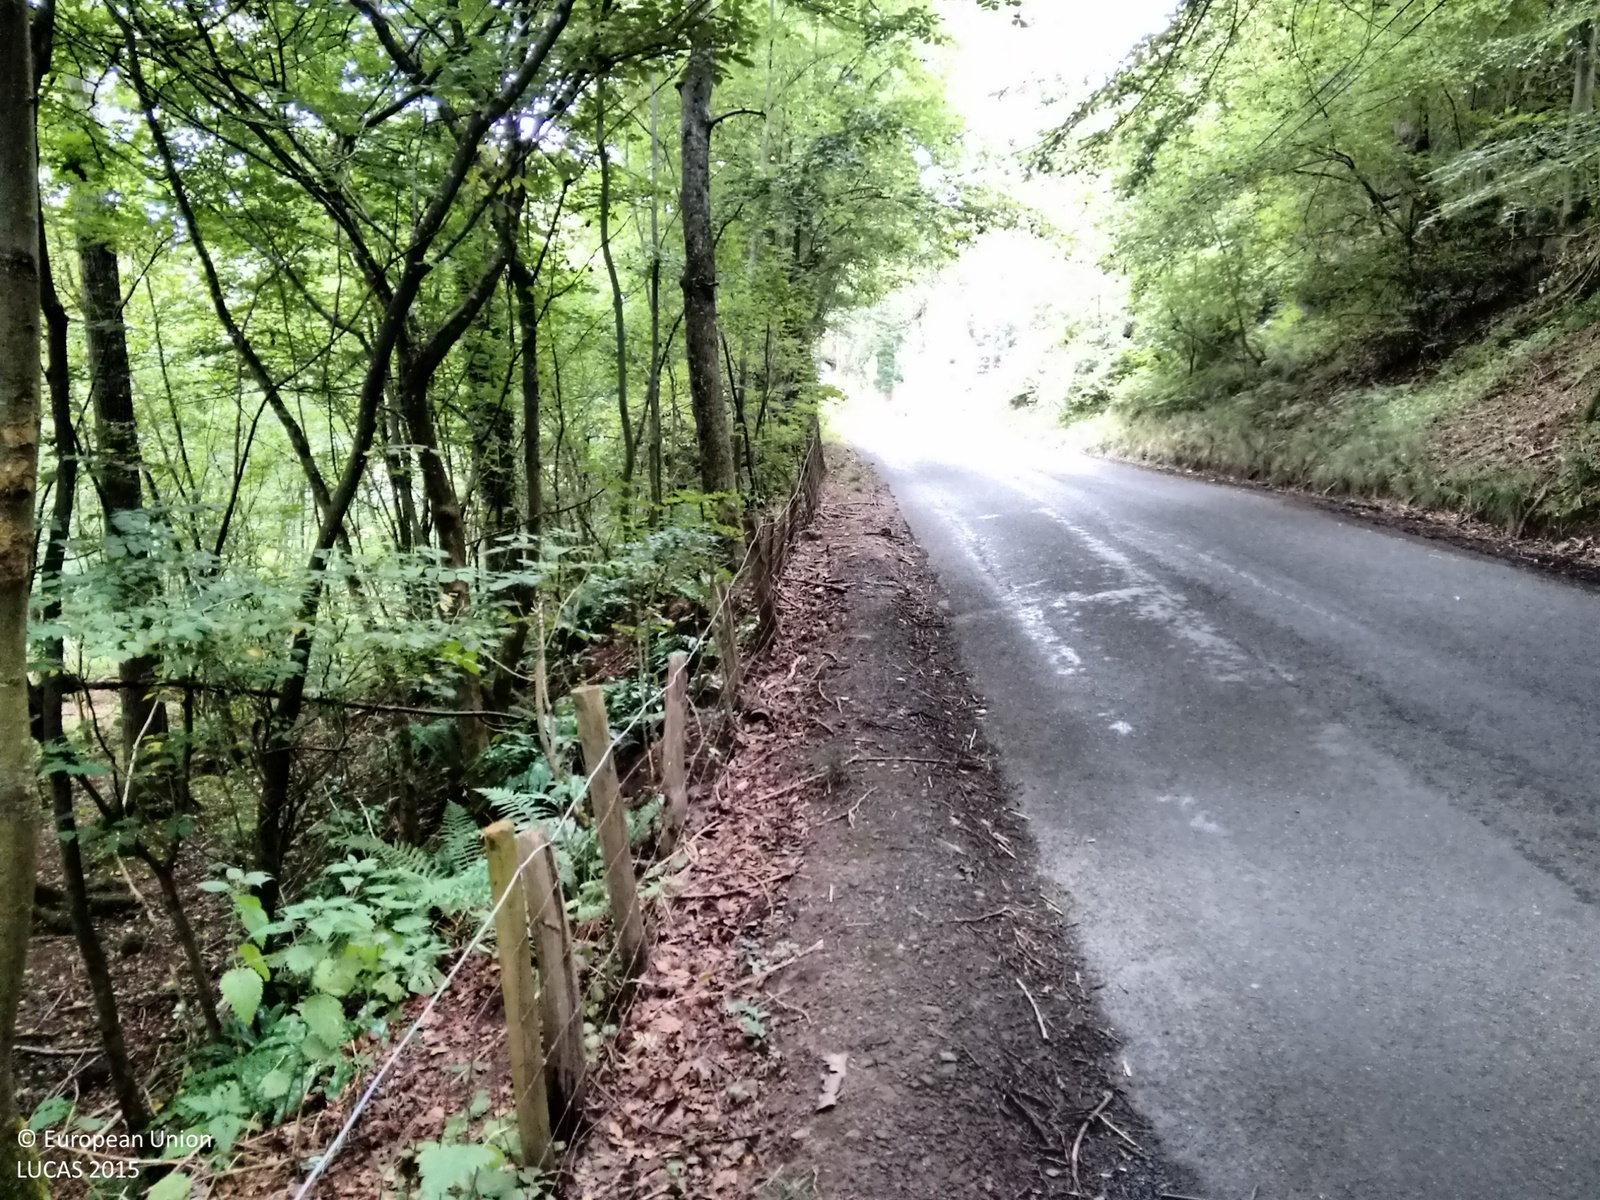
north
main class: Woodland
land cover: Broadleaved woodland
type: mesophytic deciduous forest
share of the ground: > 75 %
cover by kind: broadleaved forest trees 80 %, shrubs 20 %
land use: Semi-natural and natural areas not in use
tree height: > 5 m
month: September
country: GB
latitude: 52.0533
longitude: -3.2186
